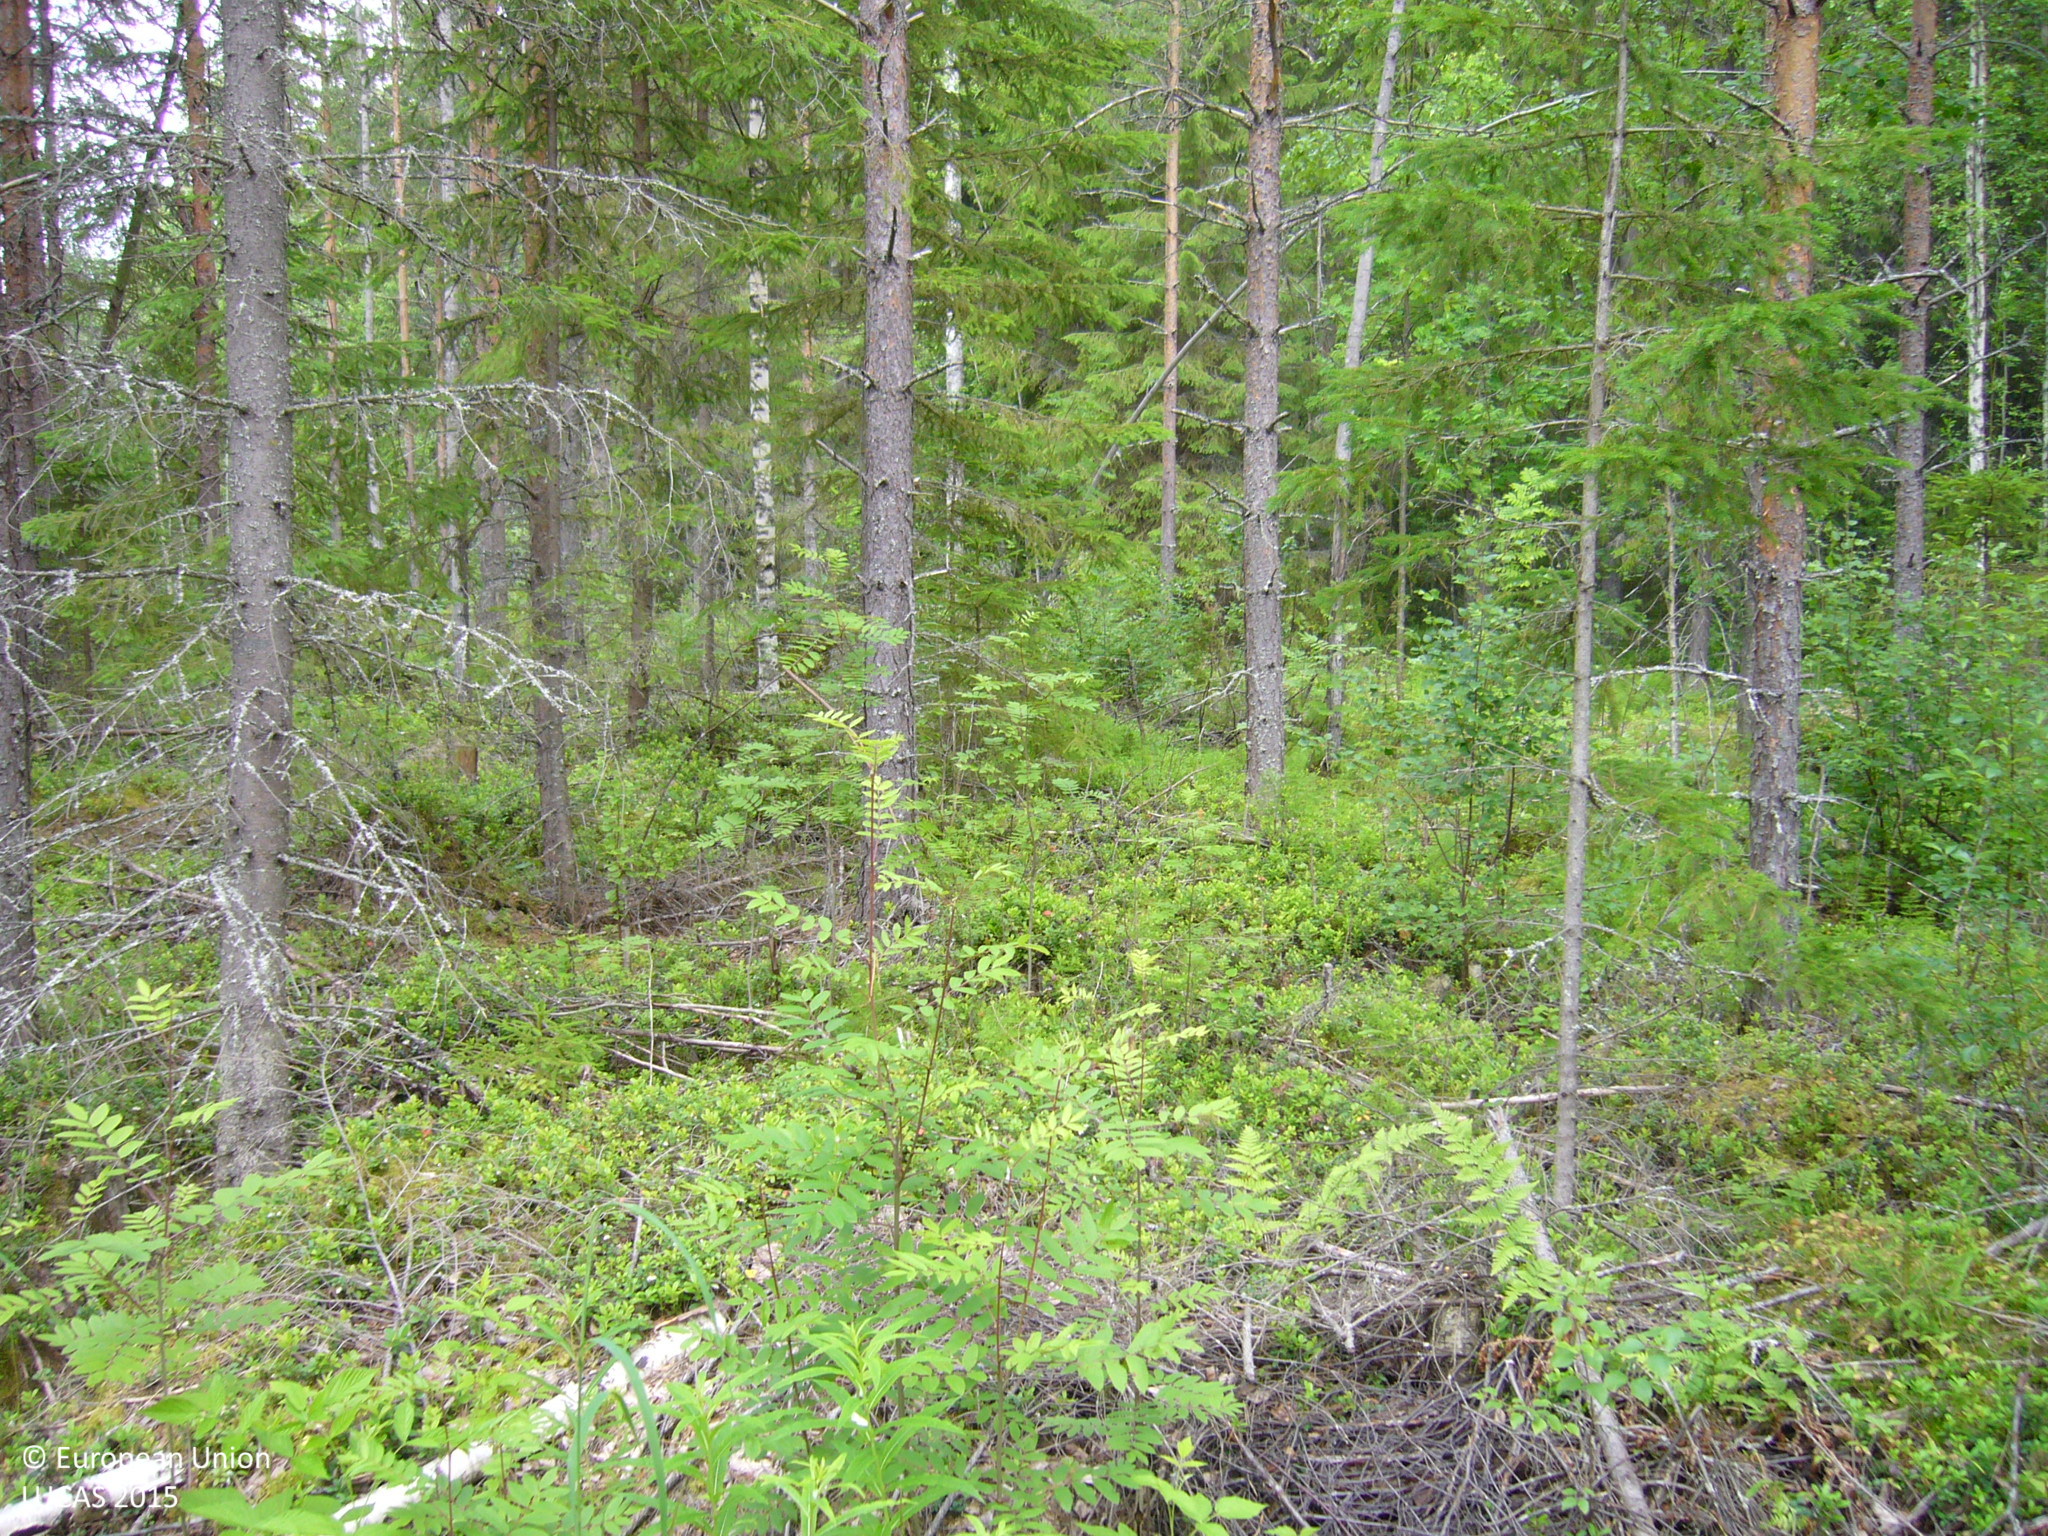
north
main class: Woodland
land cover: Pine dominated mixed woodland
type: boreal forest
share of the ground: > 75 %
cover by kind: coniferous forest trees 50 %, broadleaved forest trees 25 %, shrubs 25 %
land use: Forestry
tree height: > 5 m
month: July
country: FI
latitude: 63.1861
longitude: 26.0339
